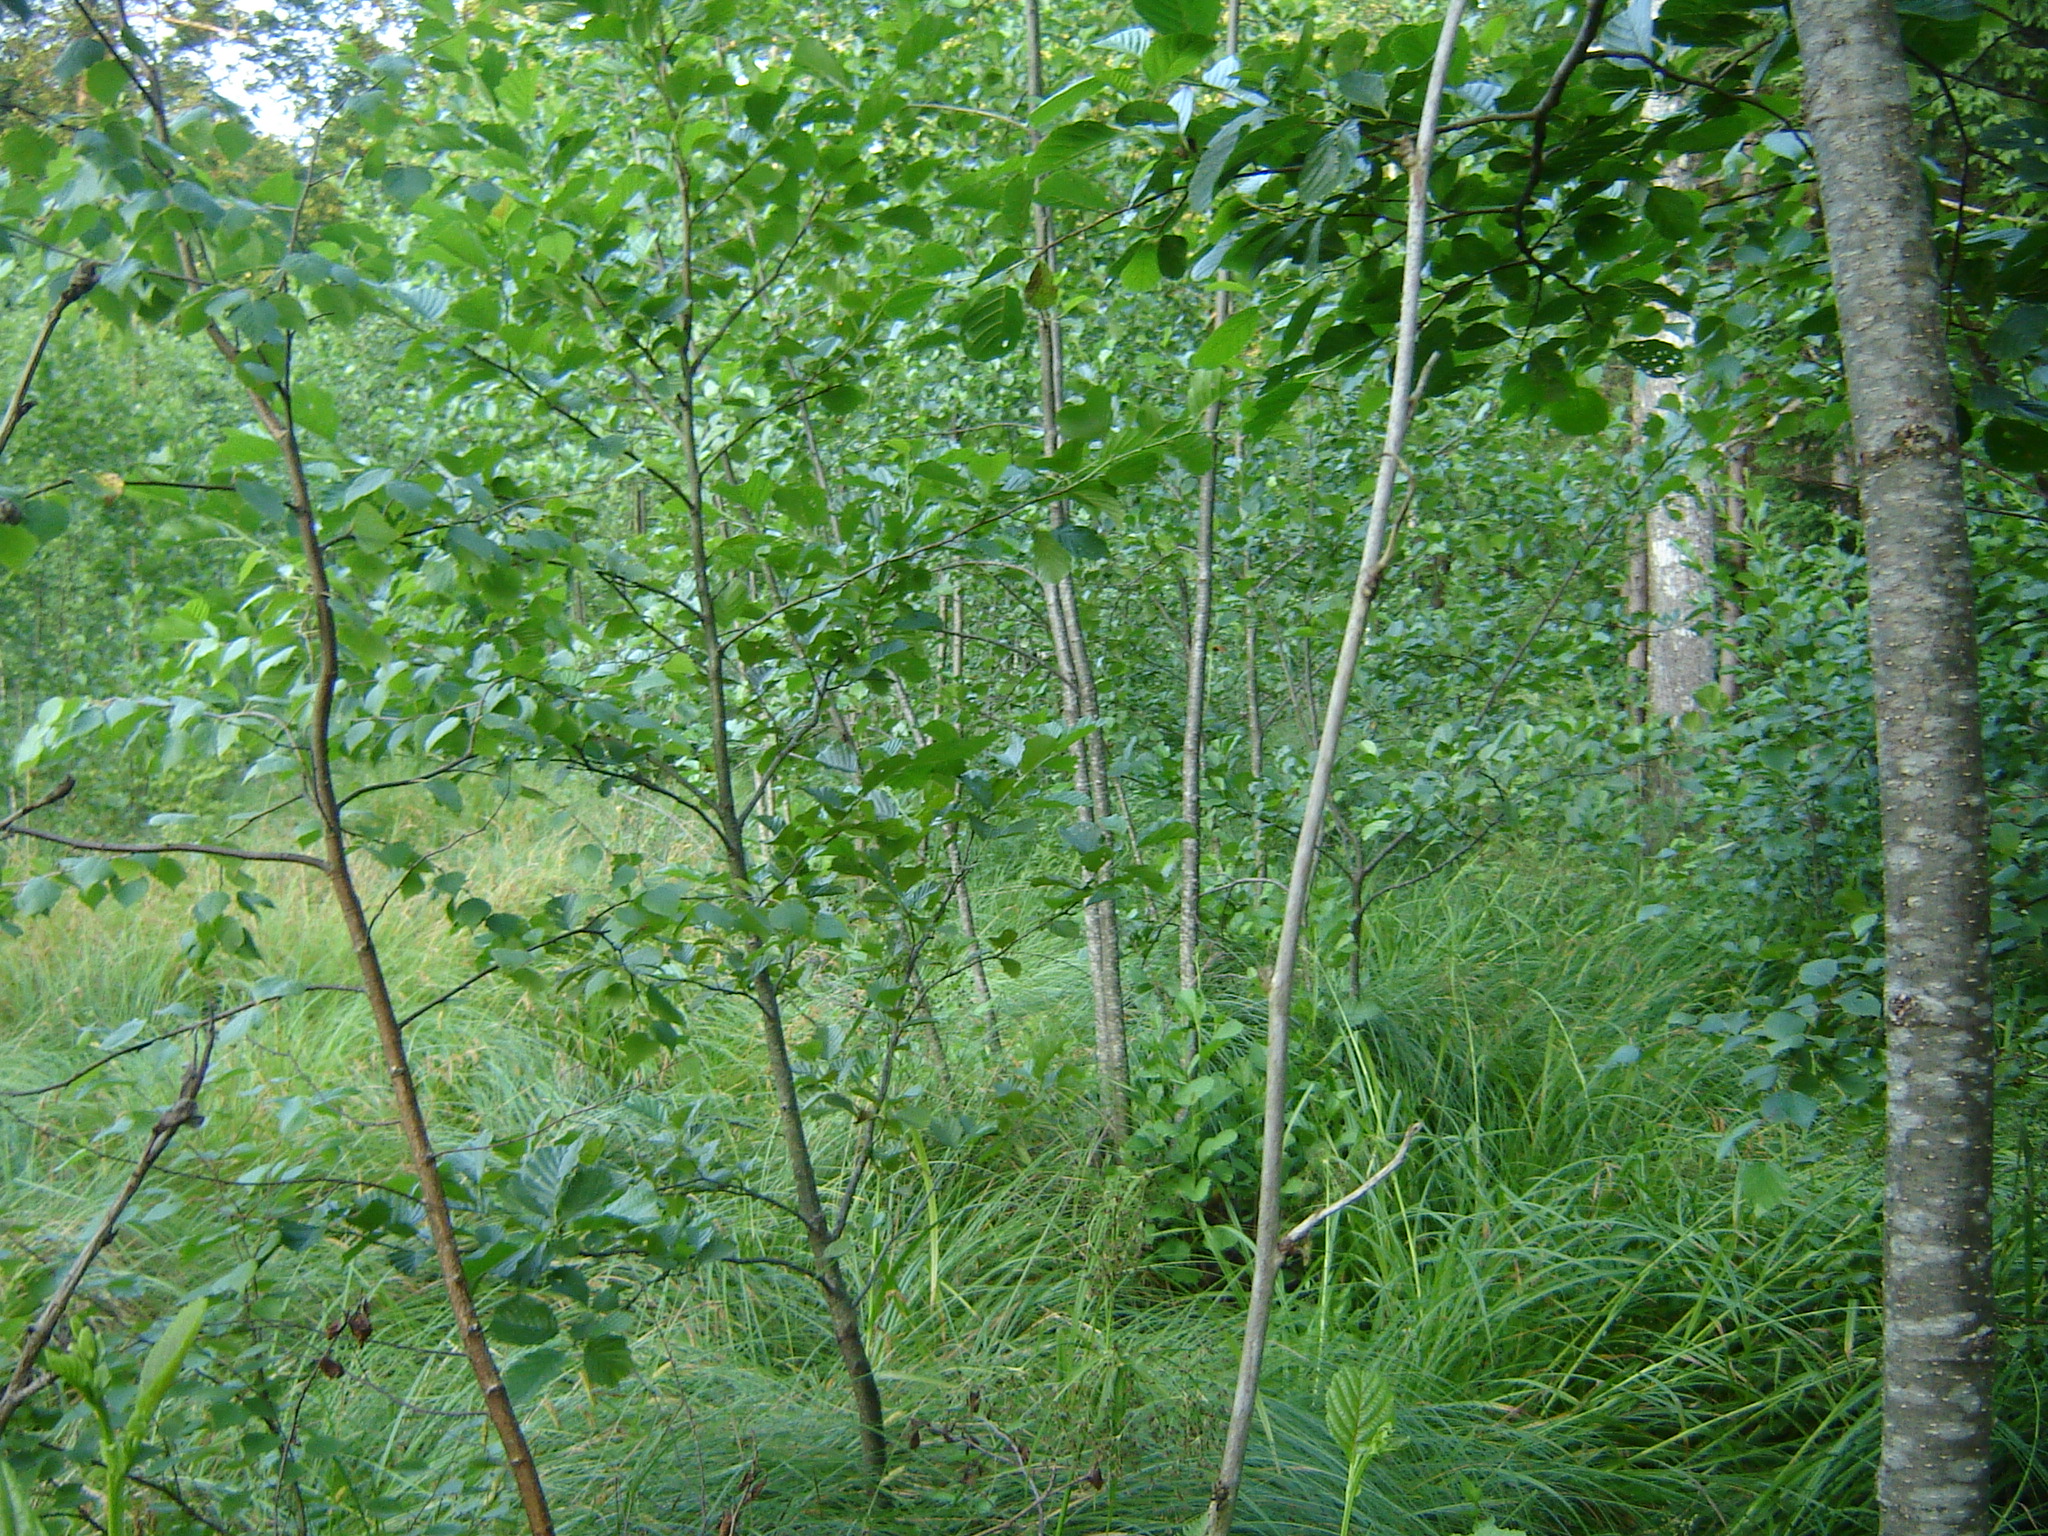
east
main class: Woodland
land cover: Broadleaved woodland
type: non-riverine alder, birch or aspen forest
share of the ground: 50 - 75 %
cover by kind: broadleaved forest trees 70 %, herbaceous plants 30 %
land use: Forestry
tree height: < 5 m
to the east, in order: Broadleaved woodland; Spruce dominated coniferous woodland; Broadleaved woodland; Tracks; Broadleaved woodland; Spruce dominated coniferous woodland; Tracks; Spruce dominated coniferous woodland; Tracks; Other mixed woodland
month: July
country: LT
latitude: 55.4485
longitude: 25.5729
